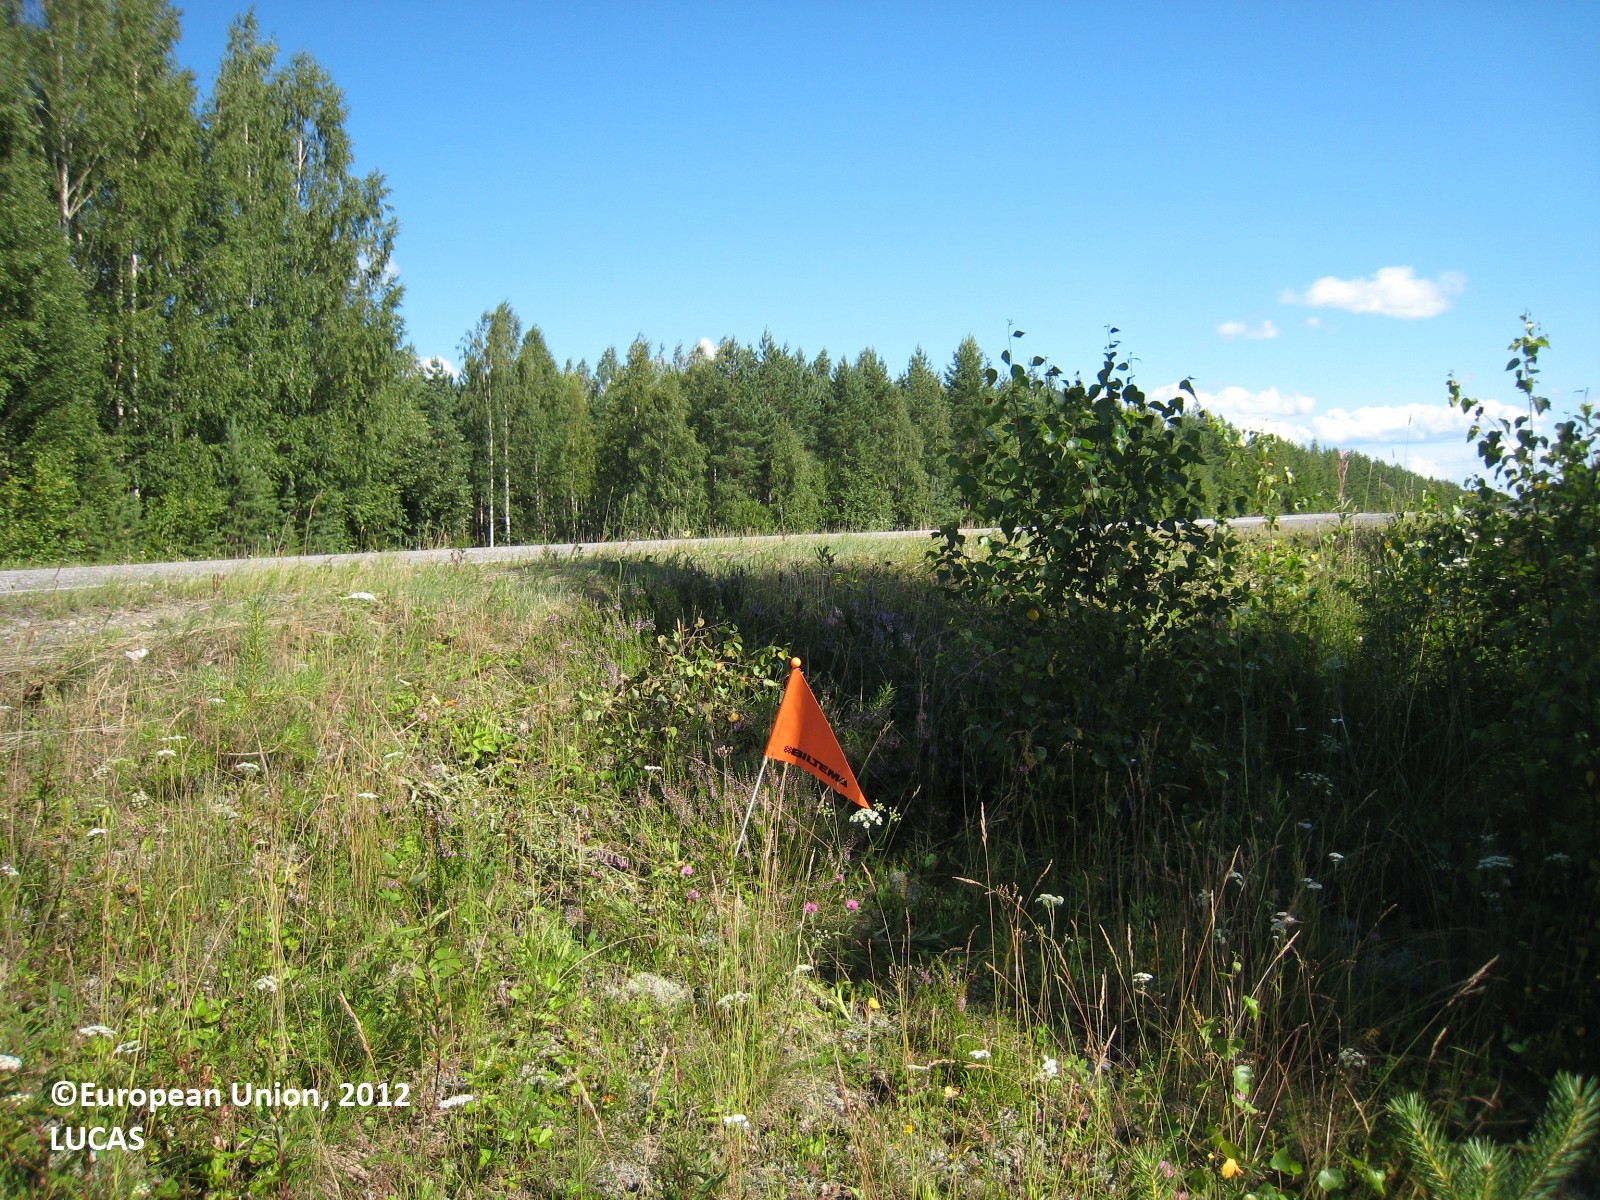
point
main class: Grassland
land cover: Grassland with sparse tree/shrub cover
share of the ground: > 75 %
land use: Road transport
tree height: < 5 m
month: July
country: FI
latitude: 62.9545
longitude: 26.7986
